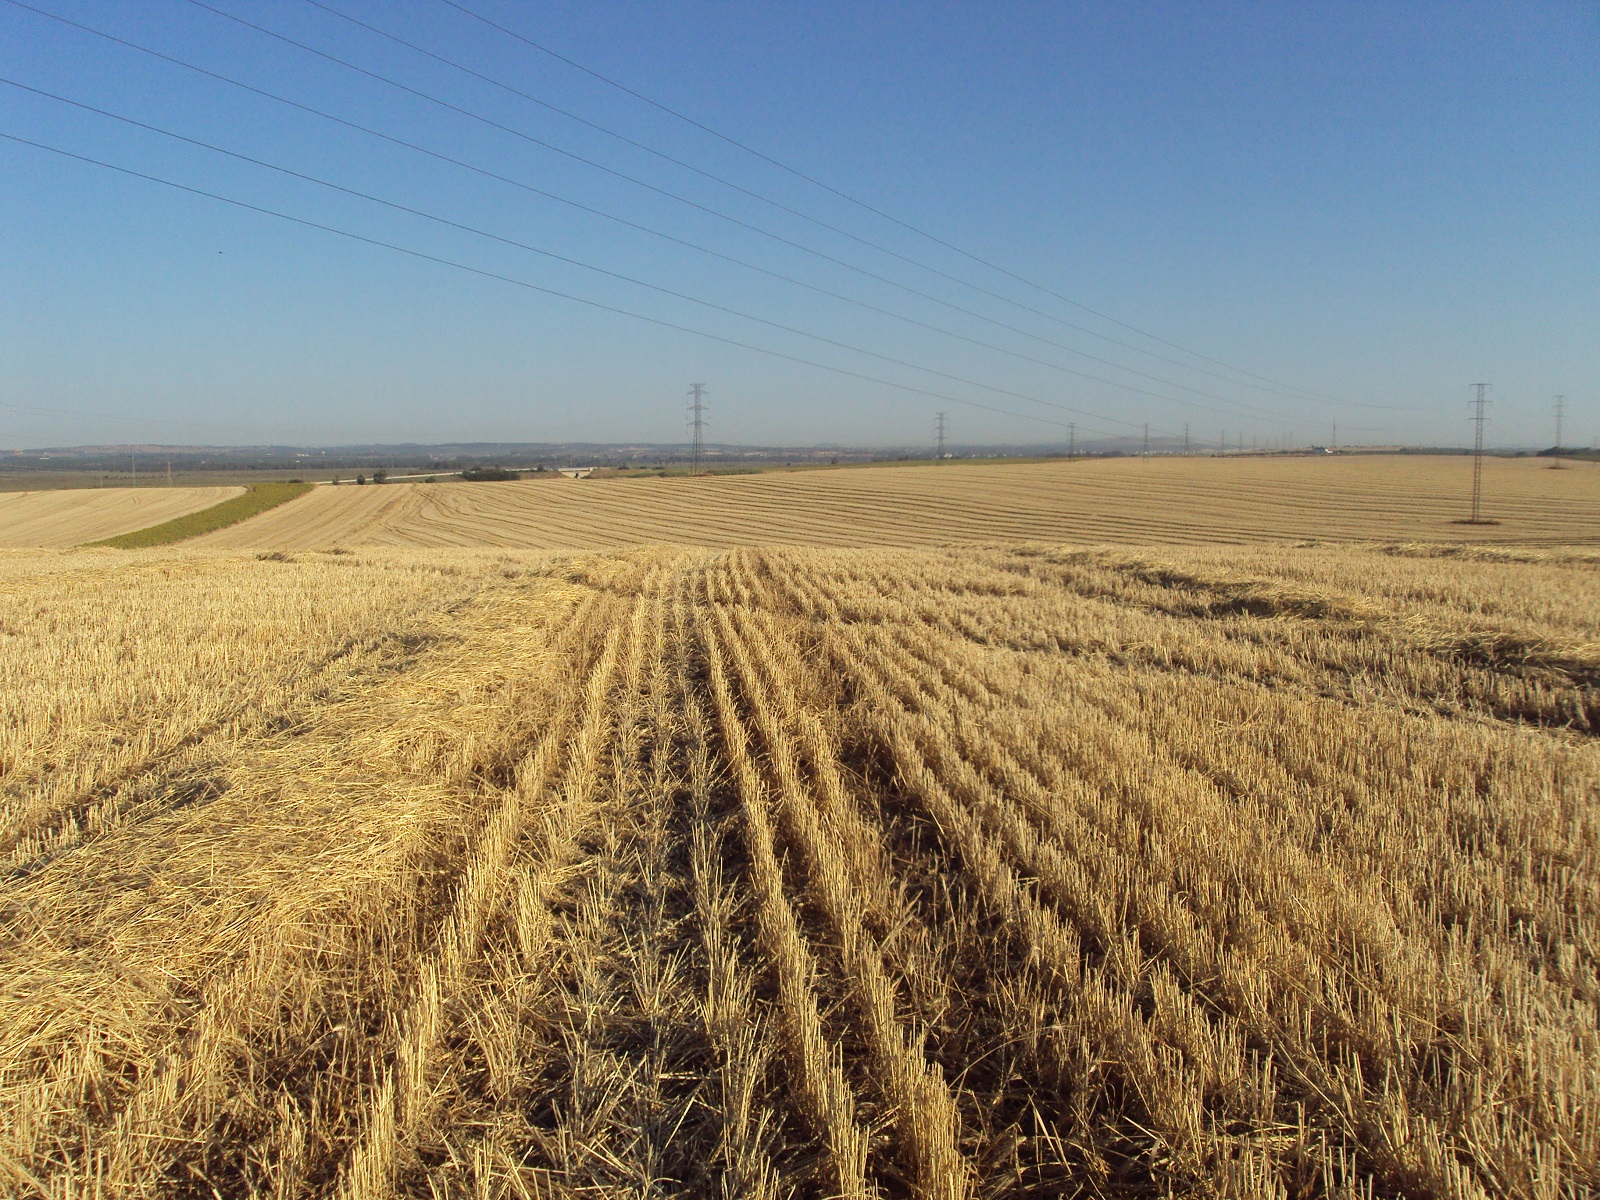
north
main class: Cropland
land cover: Durum wheat
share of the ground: > 75 %
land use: Agriculture (excluding fallow land and kitchen gardens)
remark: Harvested field
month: June
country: ES
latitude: 37.3077
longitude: -6.9290
